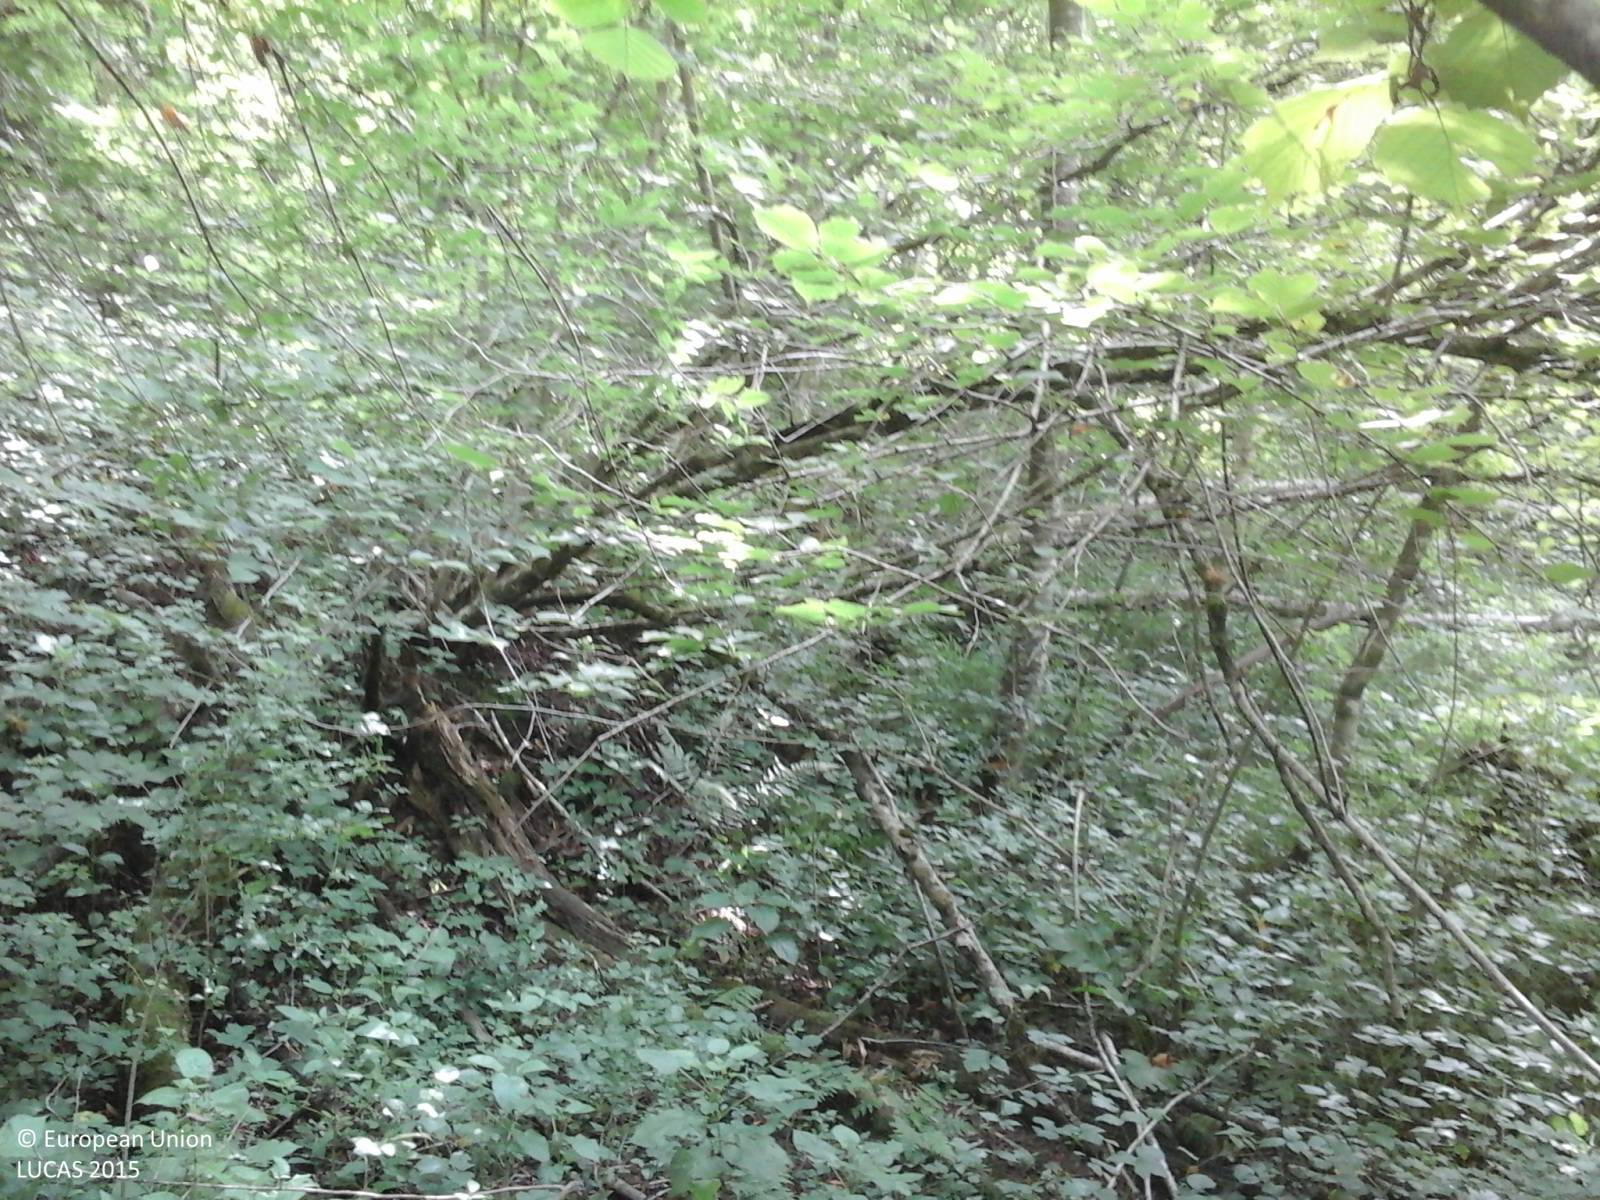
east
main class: Woodland
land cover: Broadleaved woodland
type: mesophytic deciduous forest
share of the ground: > 75 %
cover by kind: broadleaved forest trees 70 %, shrubs 20 %, herbaceous plants 10 %
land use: Forestry
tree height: > 5 m
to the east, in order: Broadleaved woodland; Rivers and streams; Broadleaved woodland
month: July
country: IT
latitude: 46.1941
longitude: 12.5755
